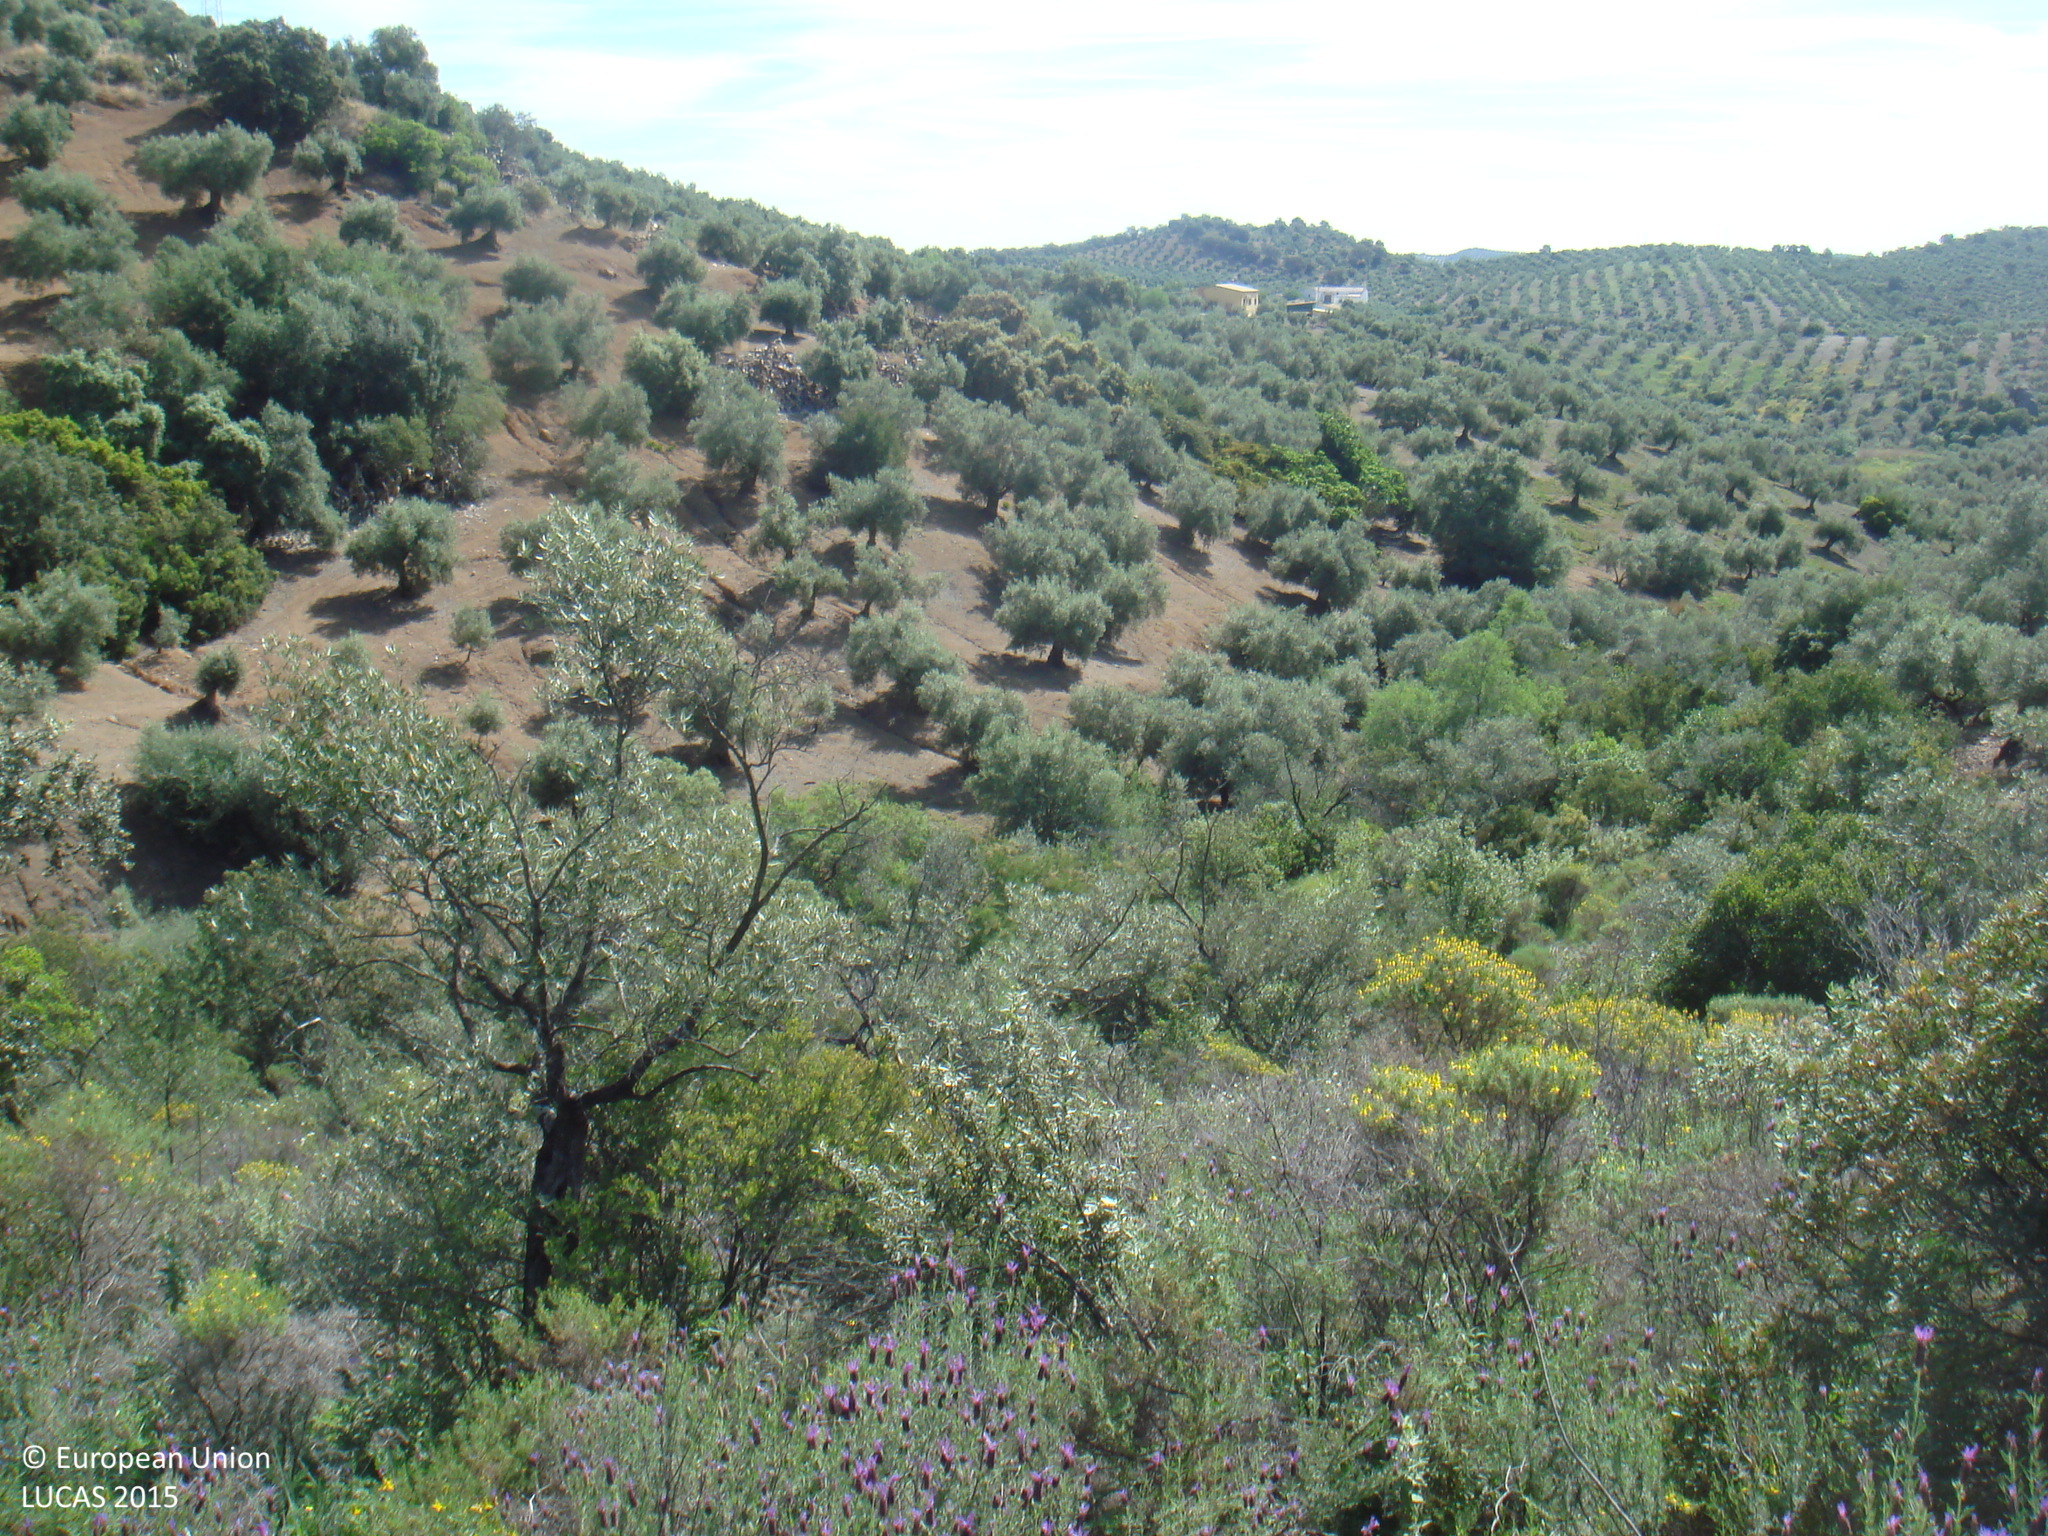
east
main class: Shrubland
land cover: Shrubland with sparse tree cover
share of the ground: > 75 %
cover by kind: shrubs 65 %, herbaceous plants 30 %, broadleaved forest trees 5 %
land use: Agriculture (excluding fallow land and kitchen gardens)
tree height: < 5 m
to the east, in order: Shrubland with sparse tree cover; Groves; Rivers and streams; Olive groves; Shrubland with sparse tree cover; Olive groves
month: April
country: ES
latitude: 38.0642
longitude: -4.6159
